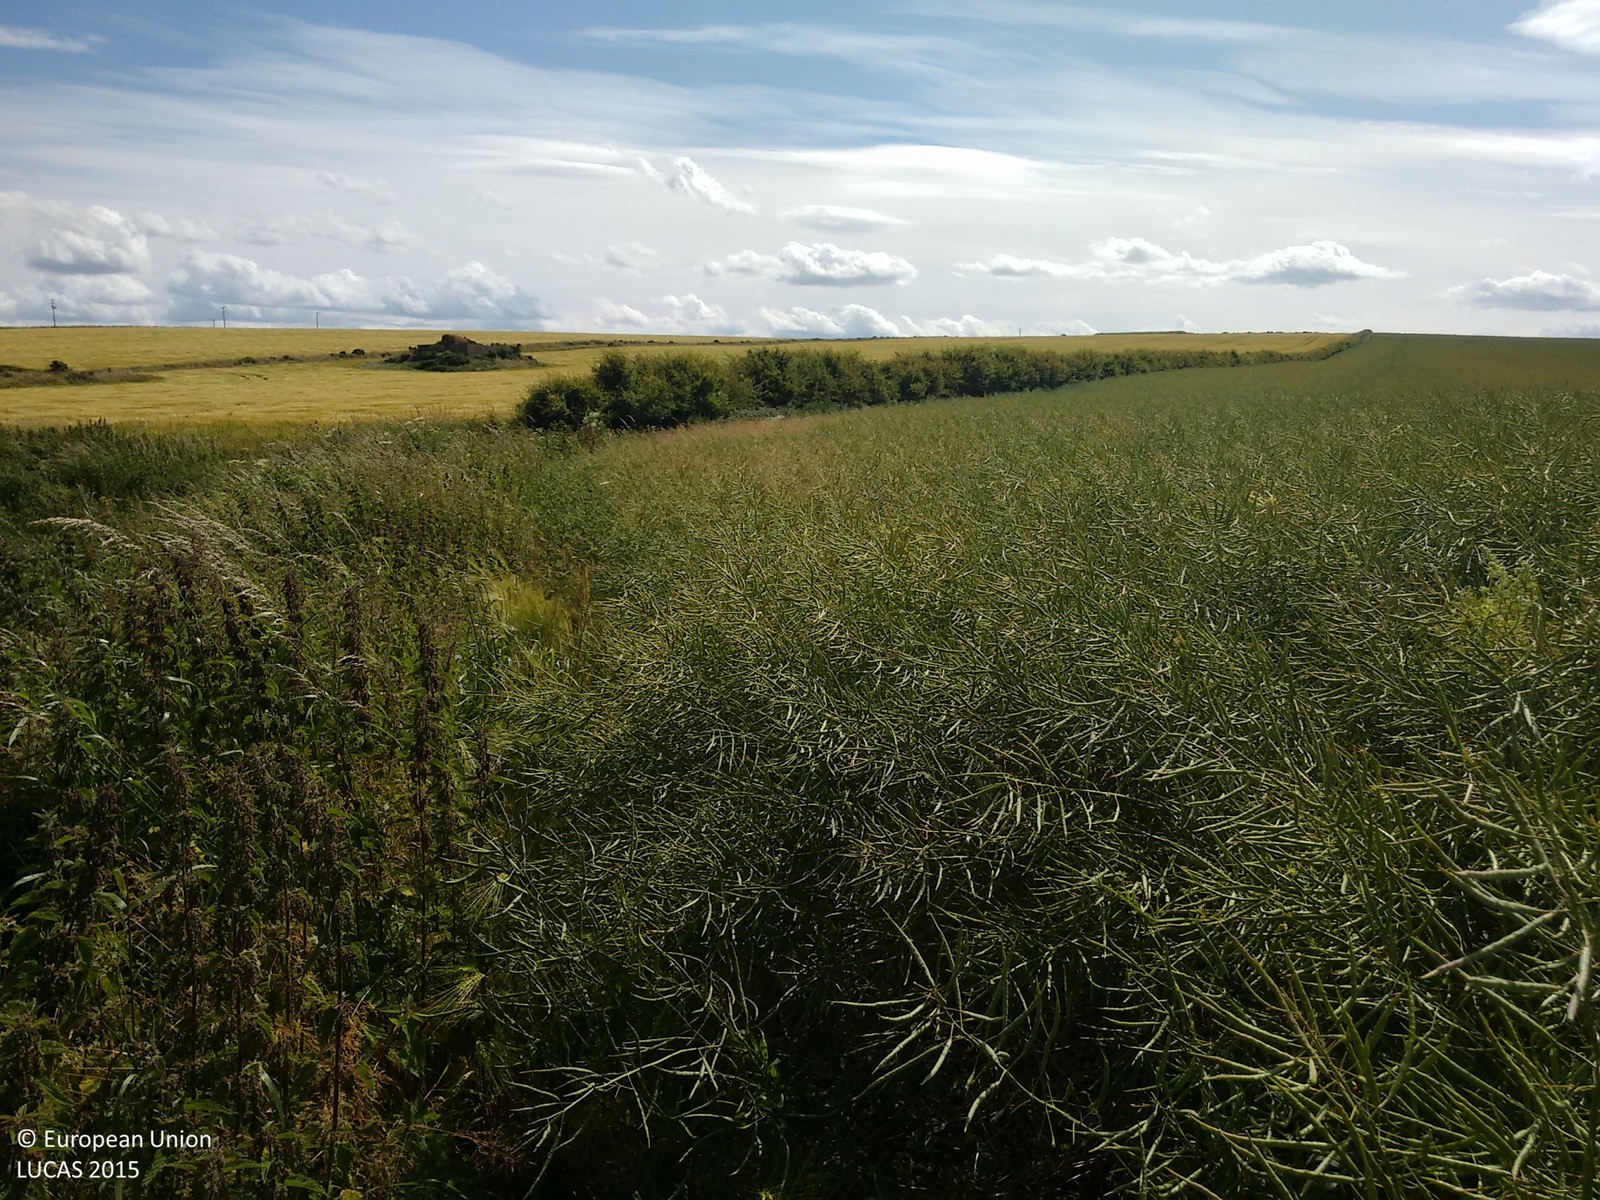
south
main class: Cropland
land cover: Rape and turnip rape
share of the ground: > 75 %
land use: Agriculture (excluding fallow land and kitchen gardens)
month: July
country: GB
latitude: 57.6527
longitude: -2.0942
